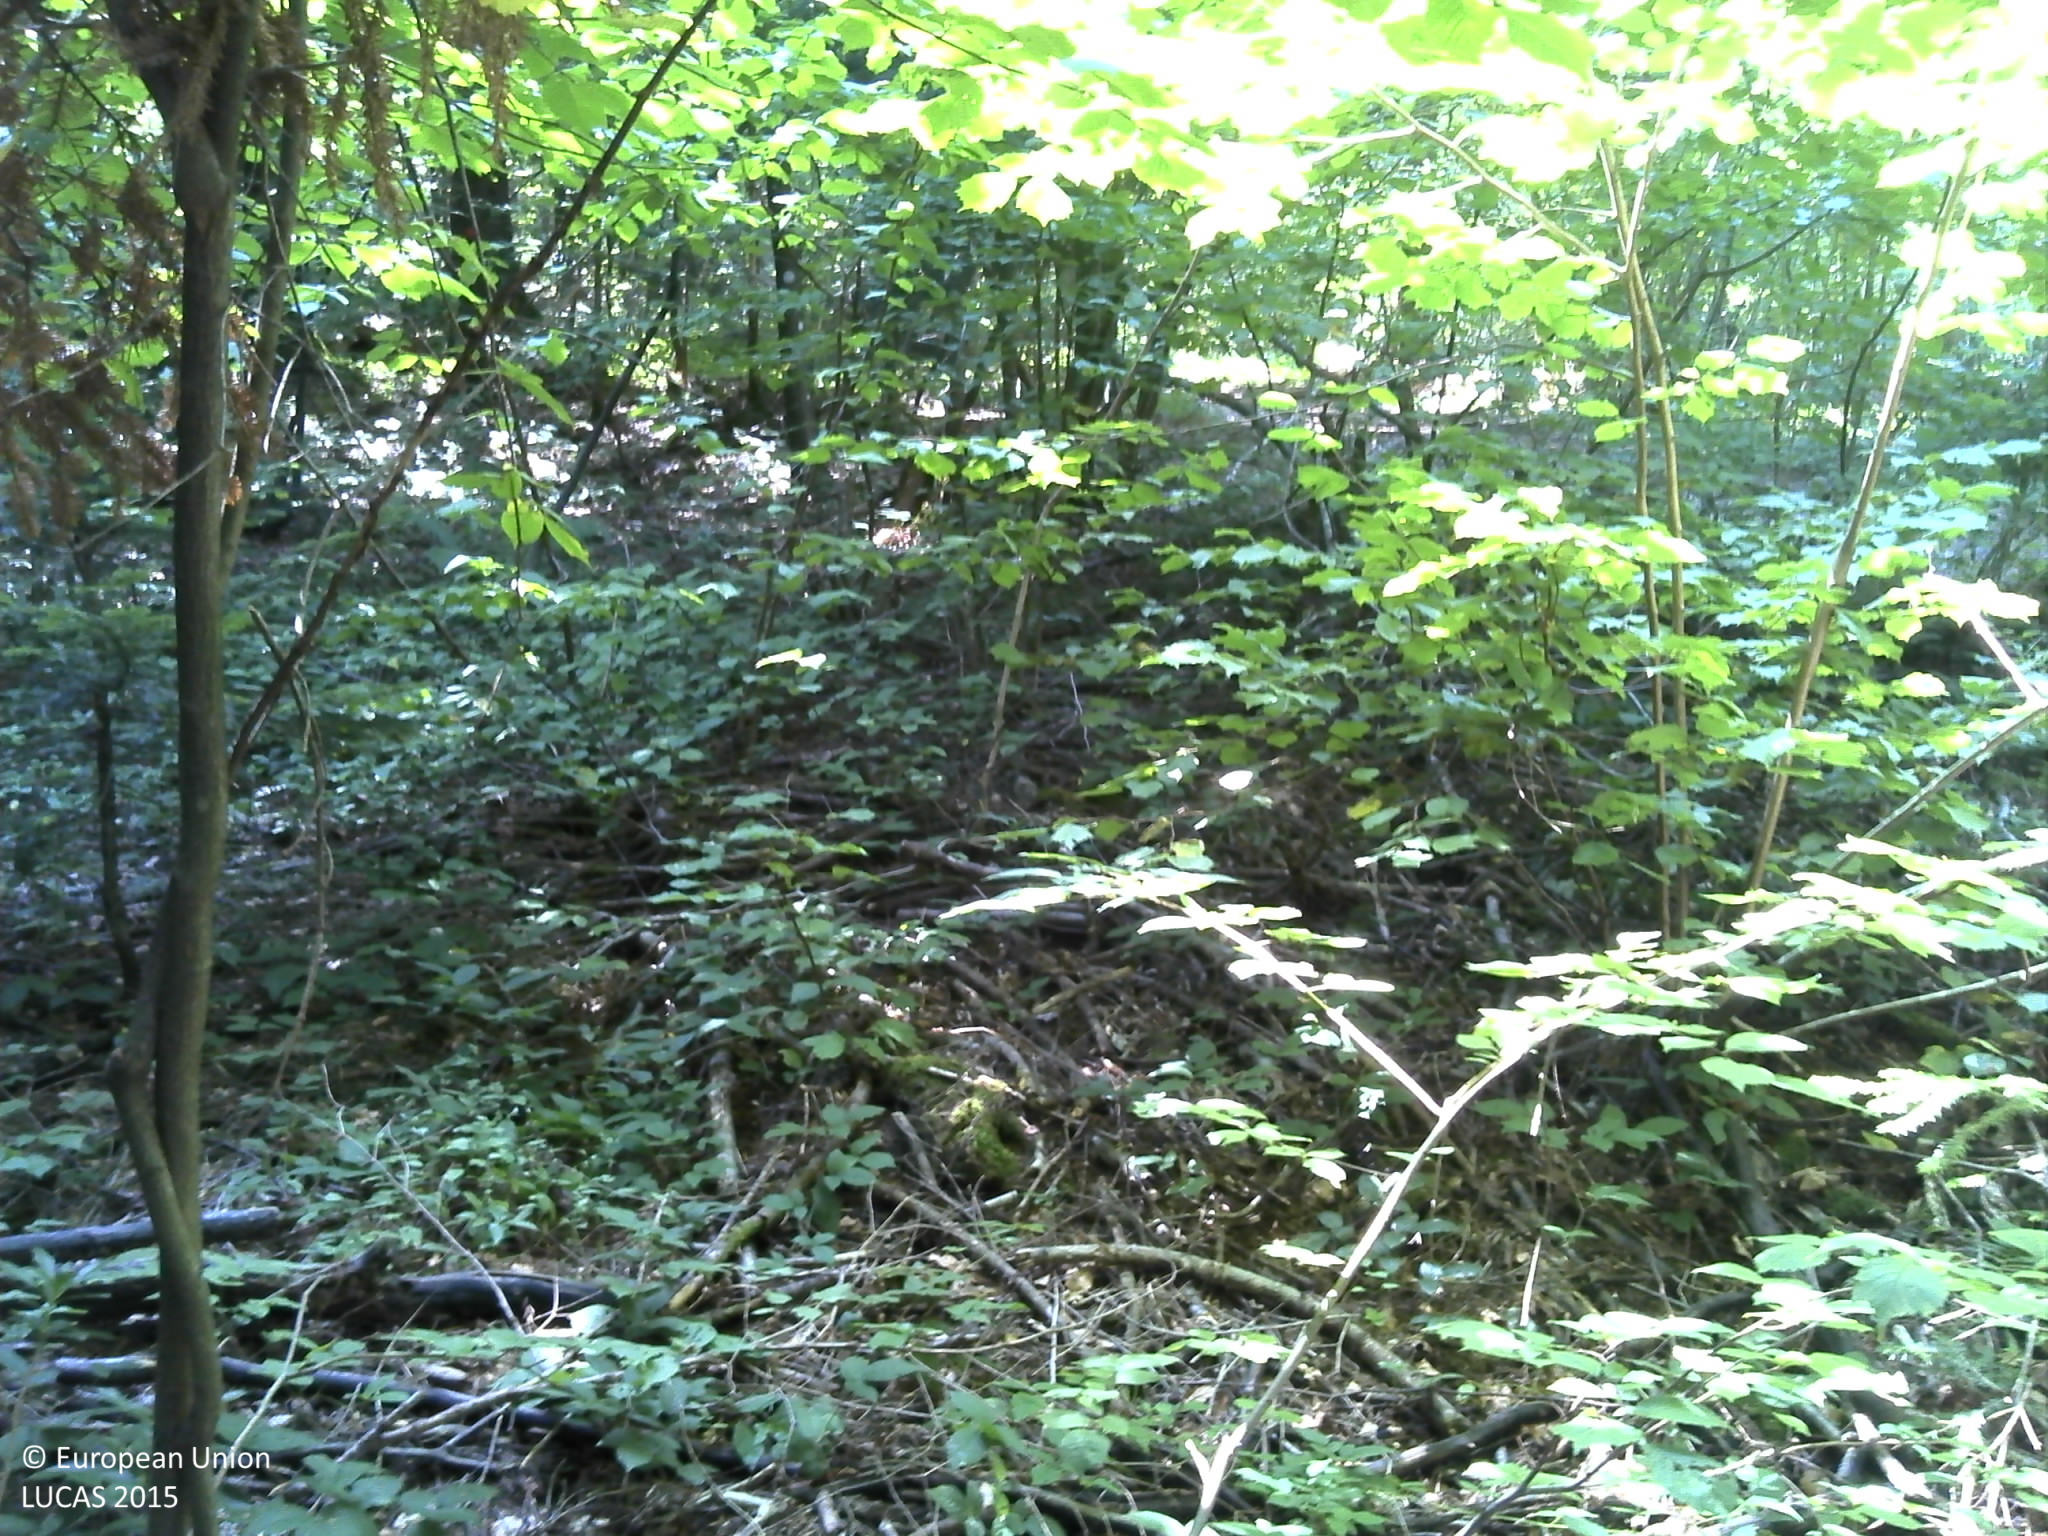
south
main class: Woodland
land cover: Pine dominated coniferous woodland
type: boreal forest
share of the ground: > 75 %
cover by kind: coniferous forest trees 100 %
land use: Forestry
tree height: > 5 m
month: August
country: HR
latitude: 45.1956
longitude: 15.2013
